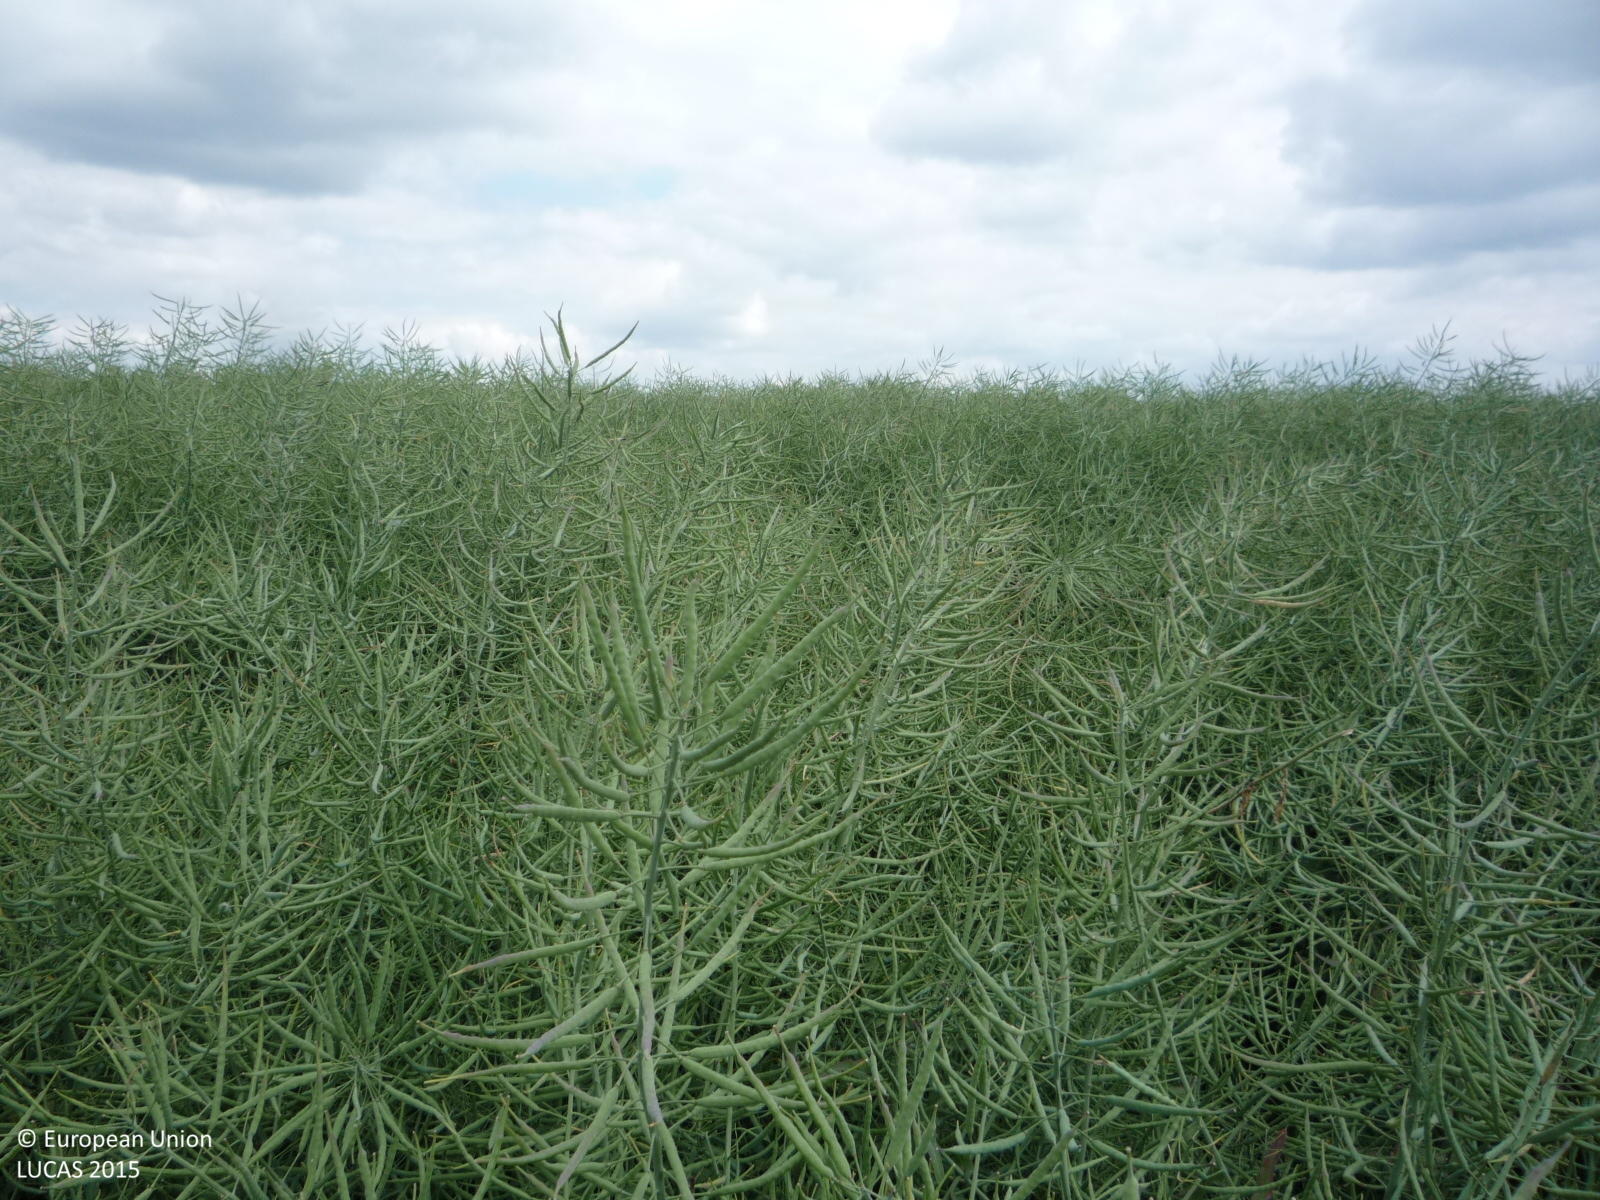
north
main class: Cropland
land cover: Rape and turnip rape
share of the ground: > 75 %
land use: Agriculture (excluding fallow land and kitchen gardens)
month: June
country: CZ
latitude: 49.7342
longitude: 14.9557
